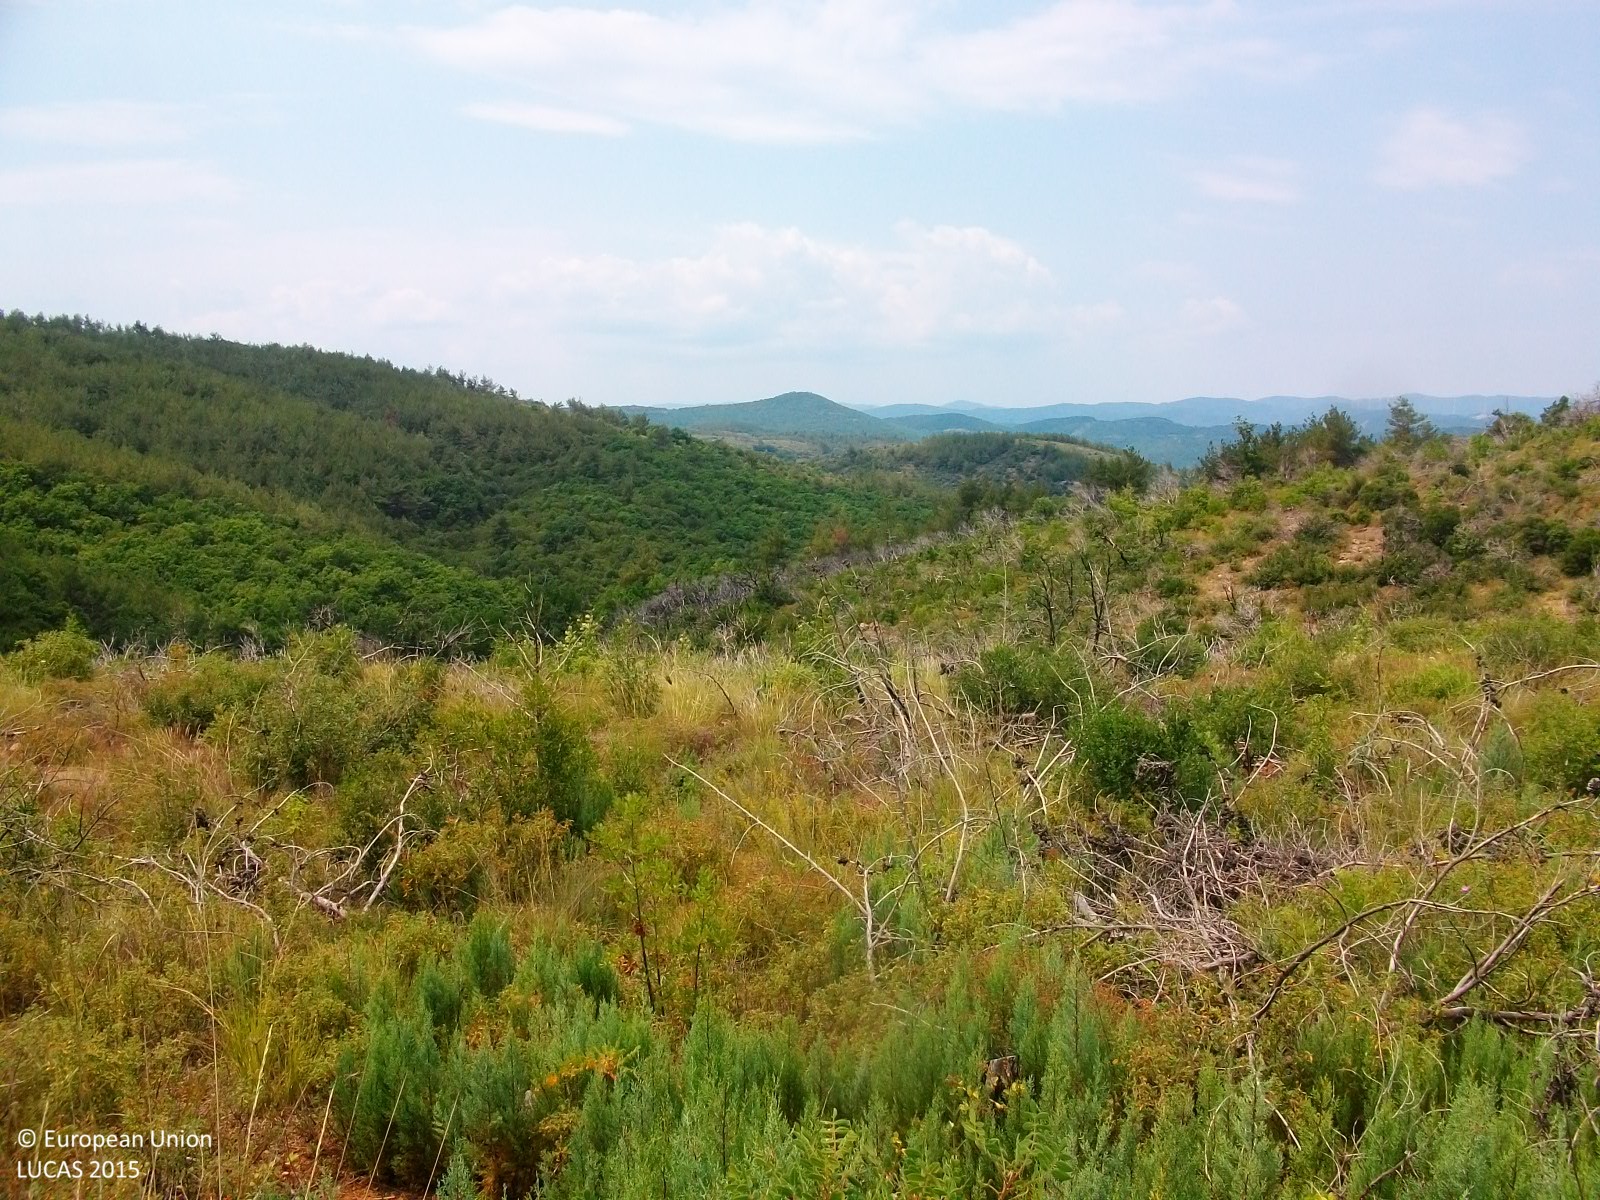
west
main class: Shrubland
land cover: Shrubland without tree cover
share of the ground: > 75 %
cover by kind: shrubs 80 %, herbaceous plants 20 %
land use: Semi-natural and natural areas not in use
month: July
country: GR
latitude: 41.0065
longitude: 26.1021
